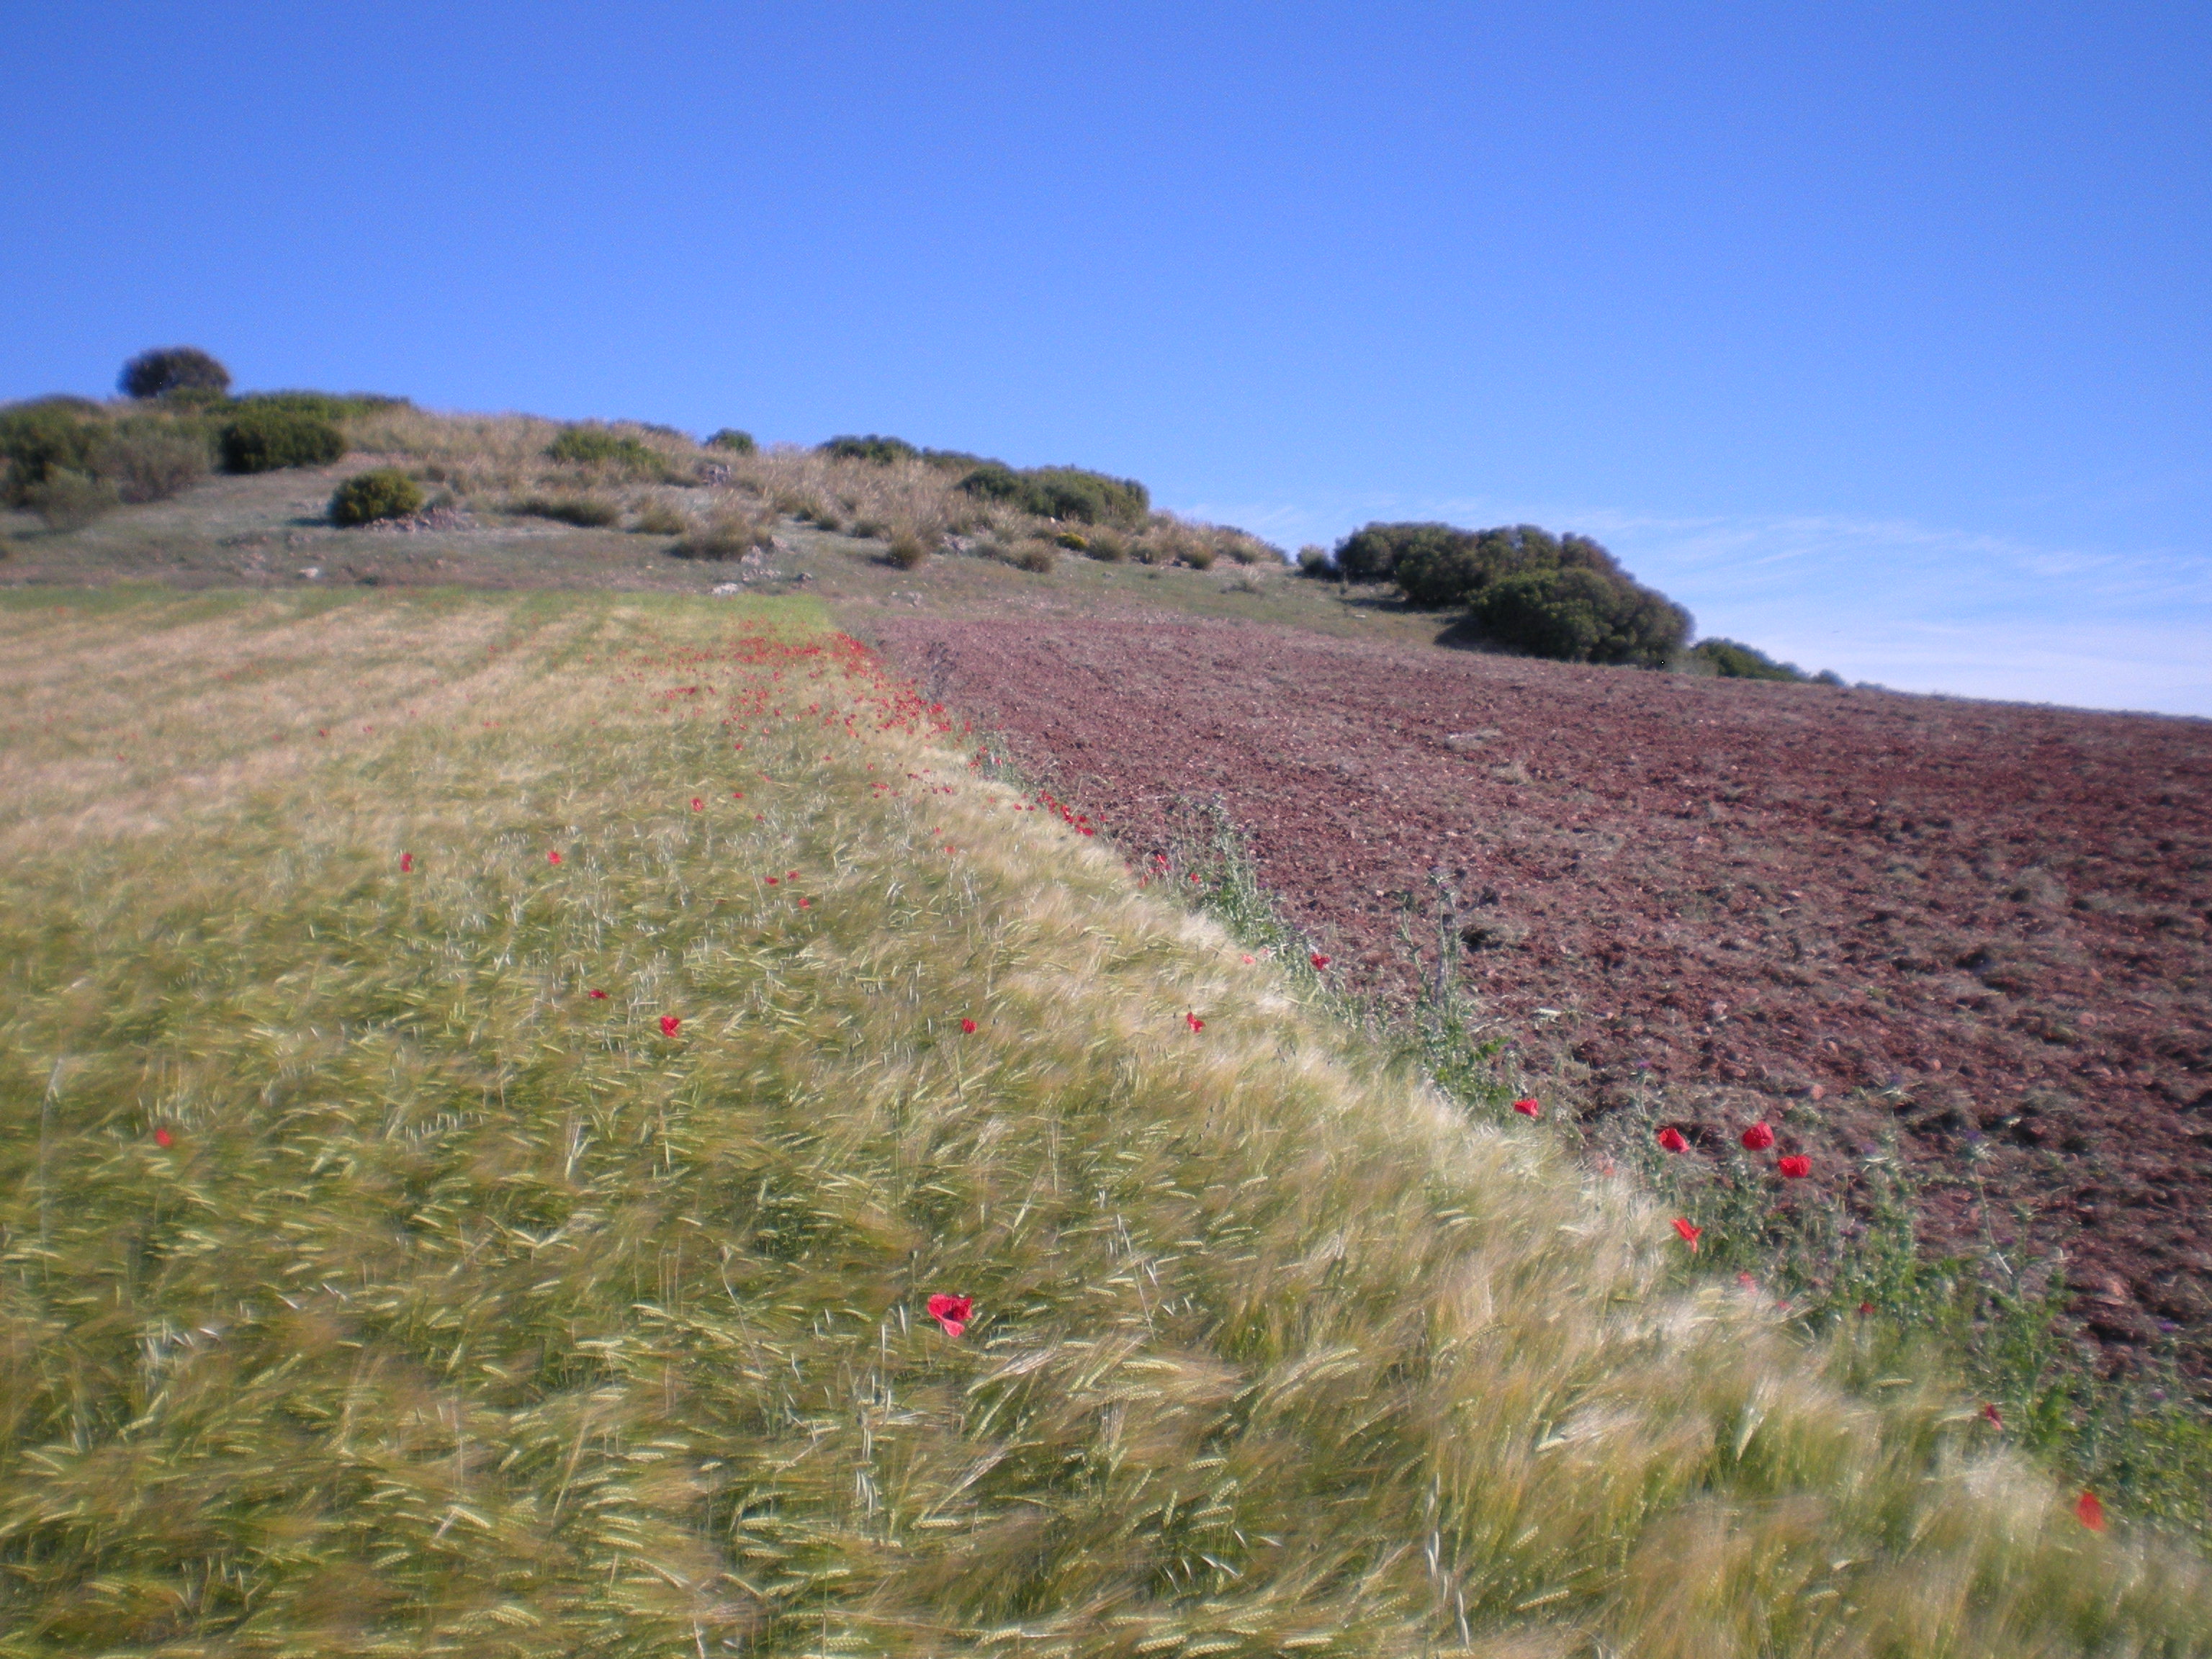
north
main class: Cropland
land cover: Barley
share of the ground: > 75 %
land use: Agriculture (excluding fallow land and kitchen gardens)
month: May
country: ES
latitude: 38.9298
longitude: -3.0797
